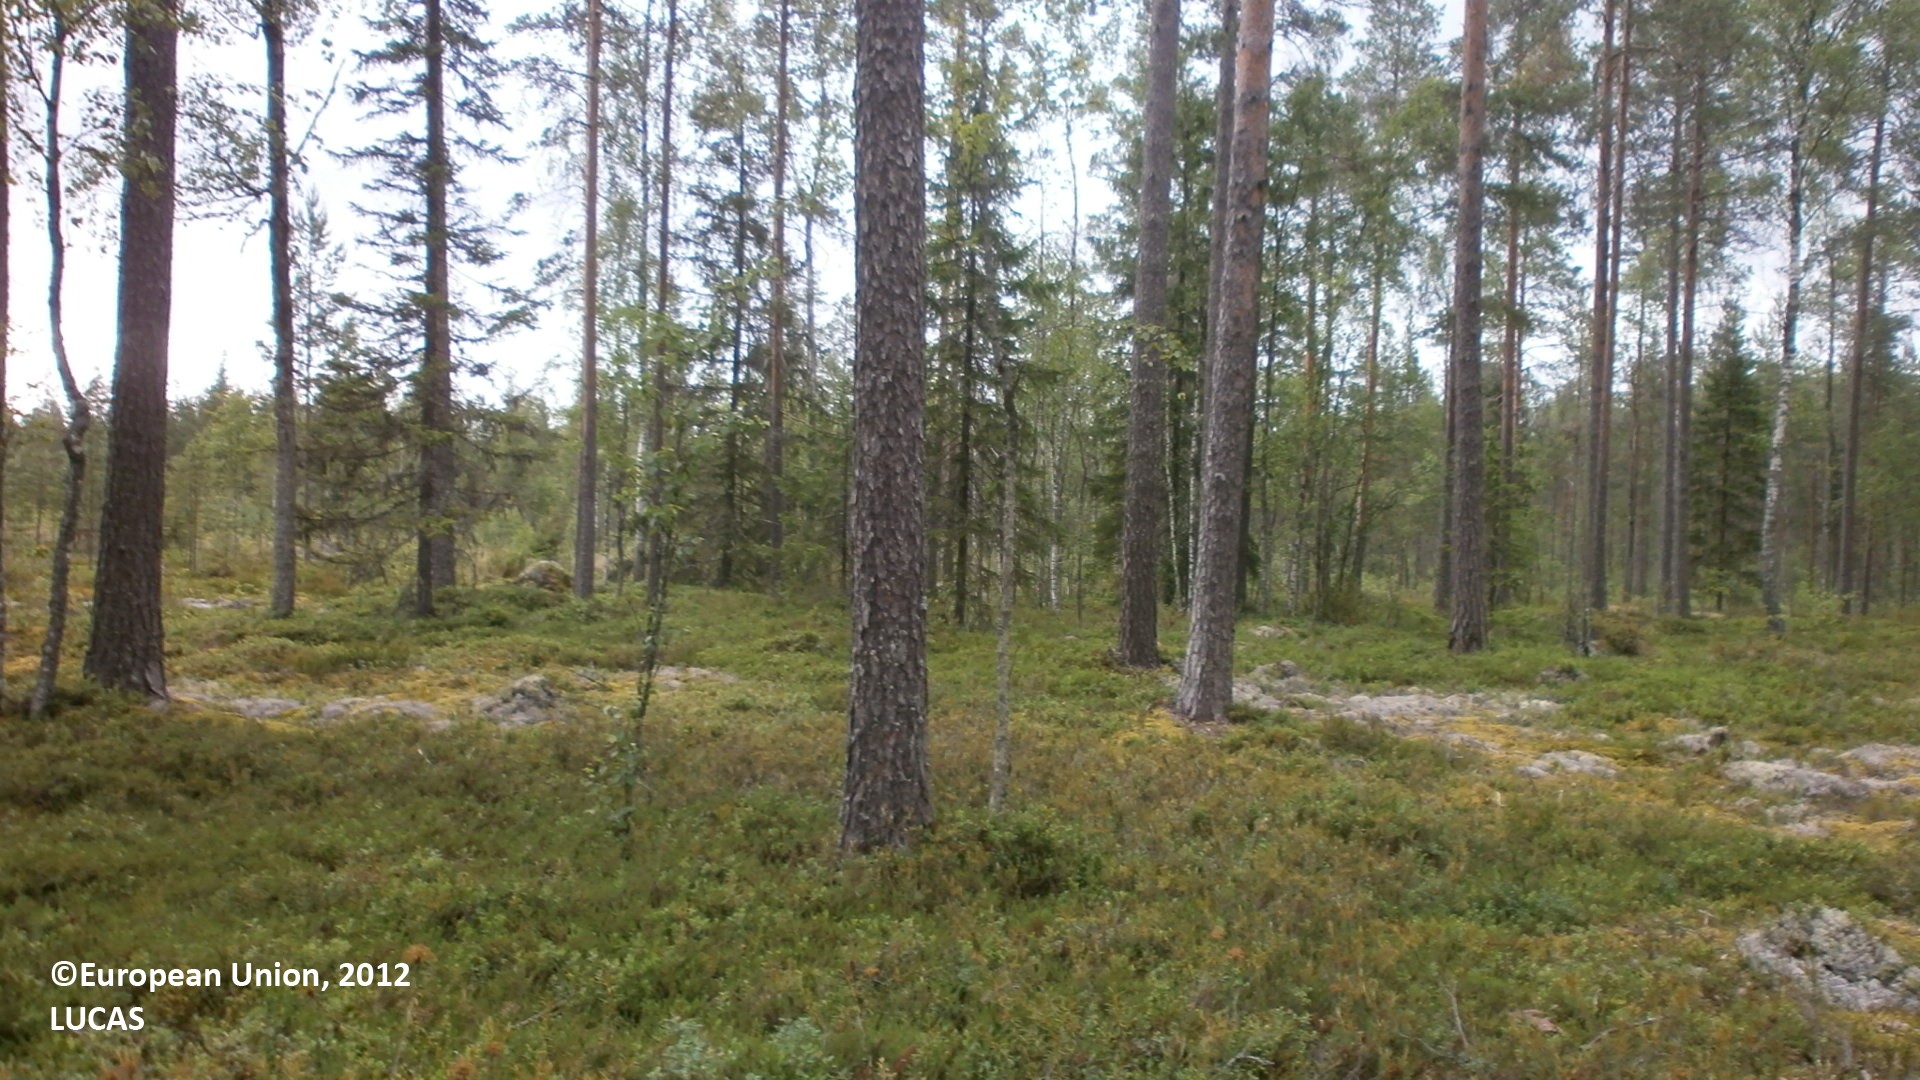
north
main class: Woodland
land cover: Pine dominated coniferous woodland
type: boreal forest
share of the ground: 50 - 75 %
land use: Forestry
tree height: > 5 m
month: July
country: FI
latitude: 63.9387
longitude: 24.2078
